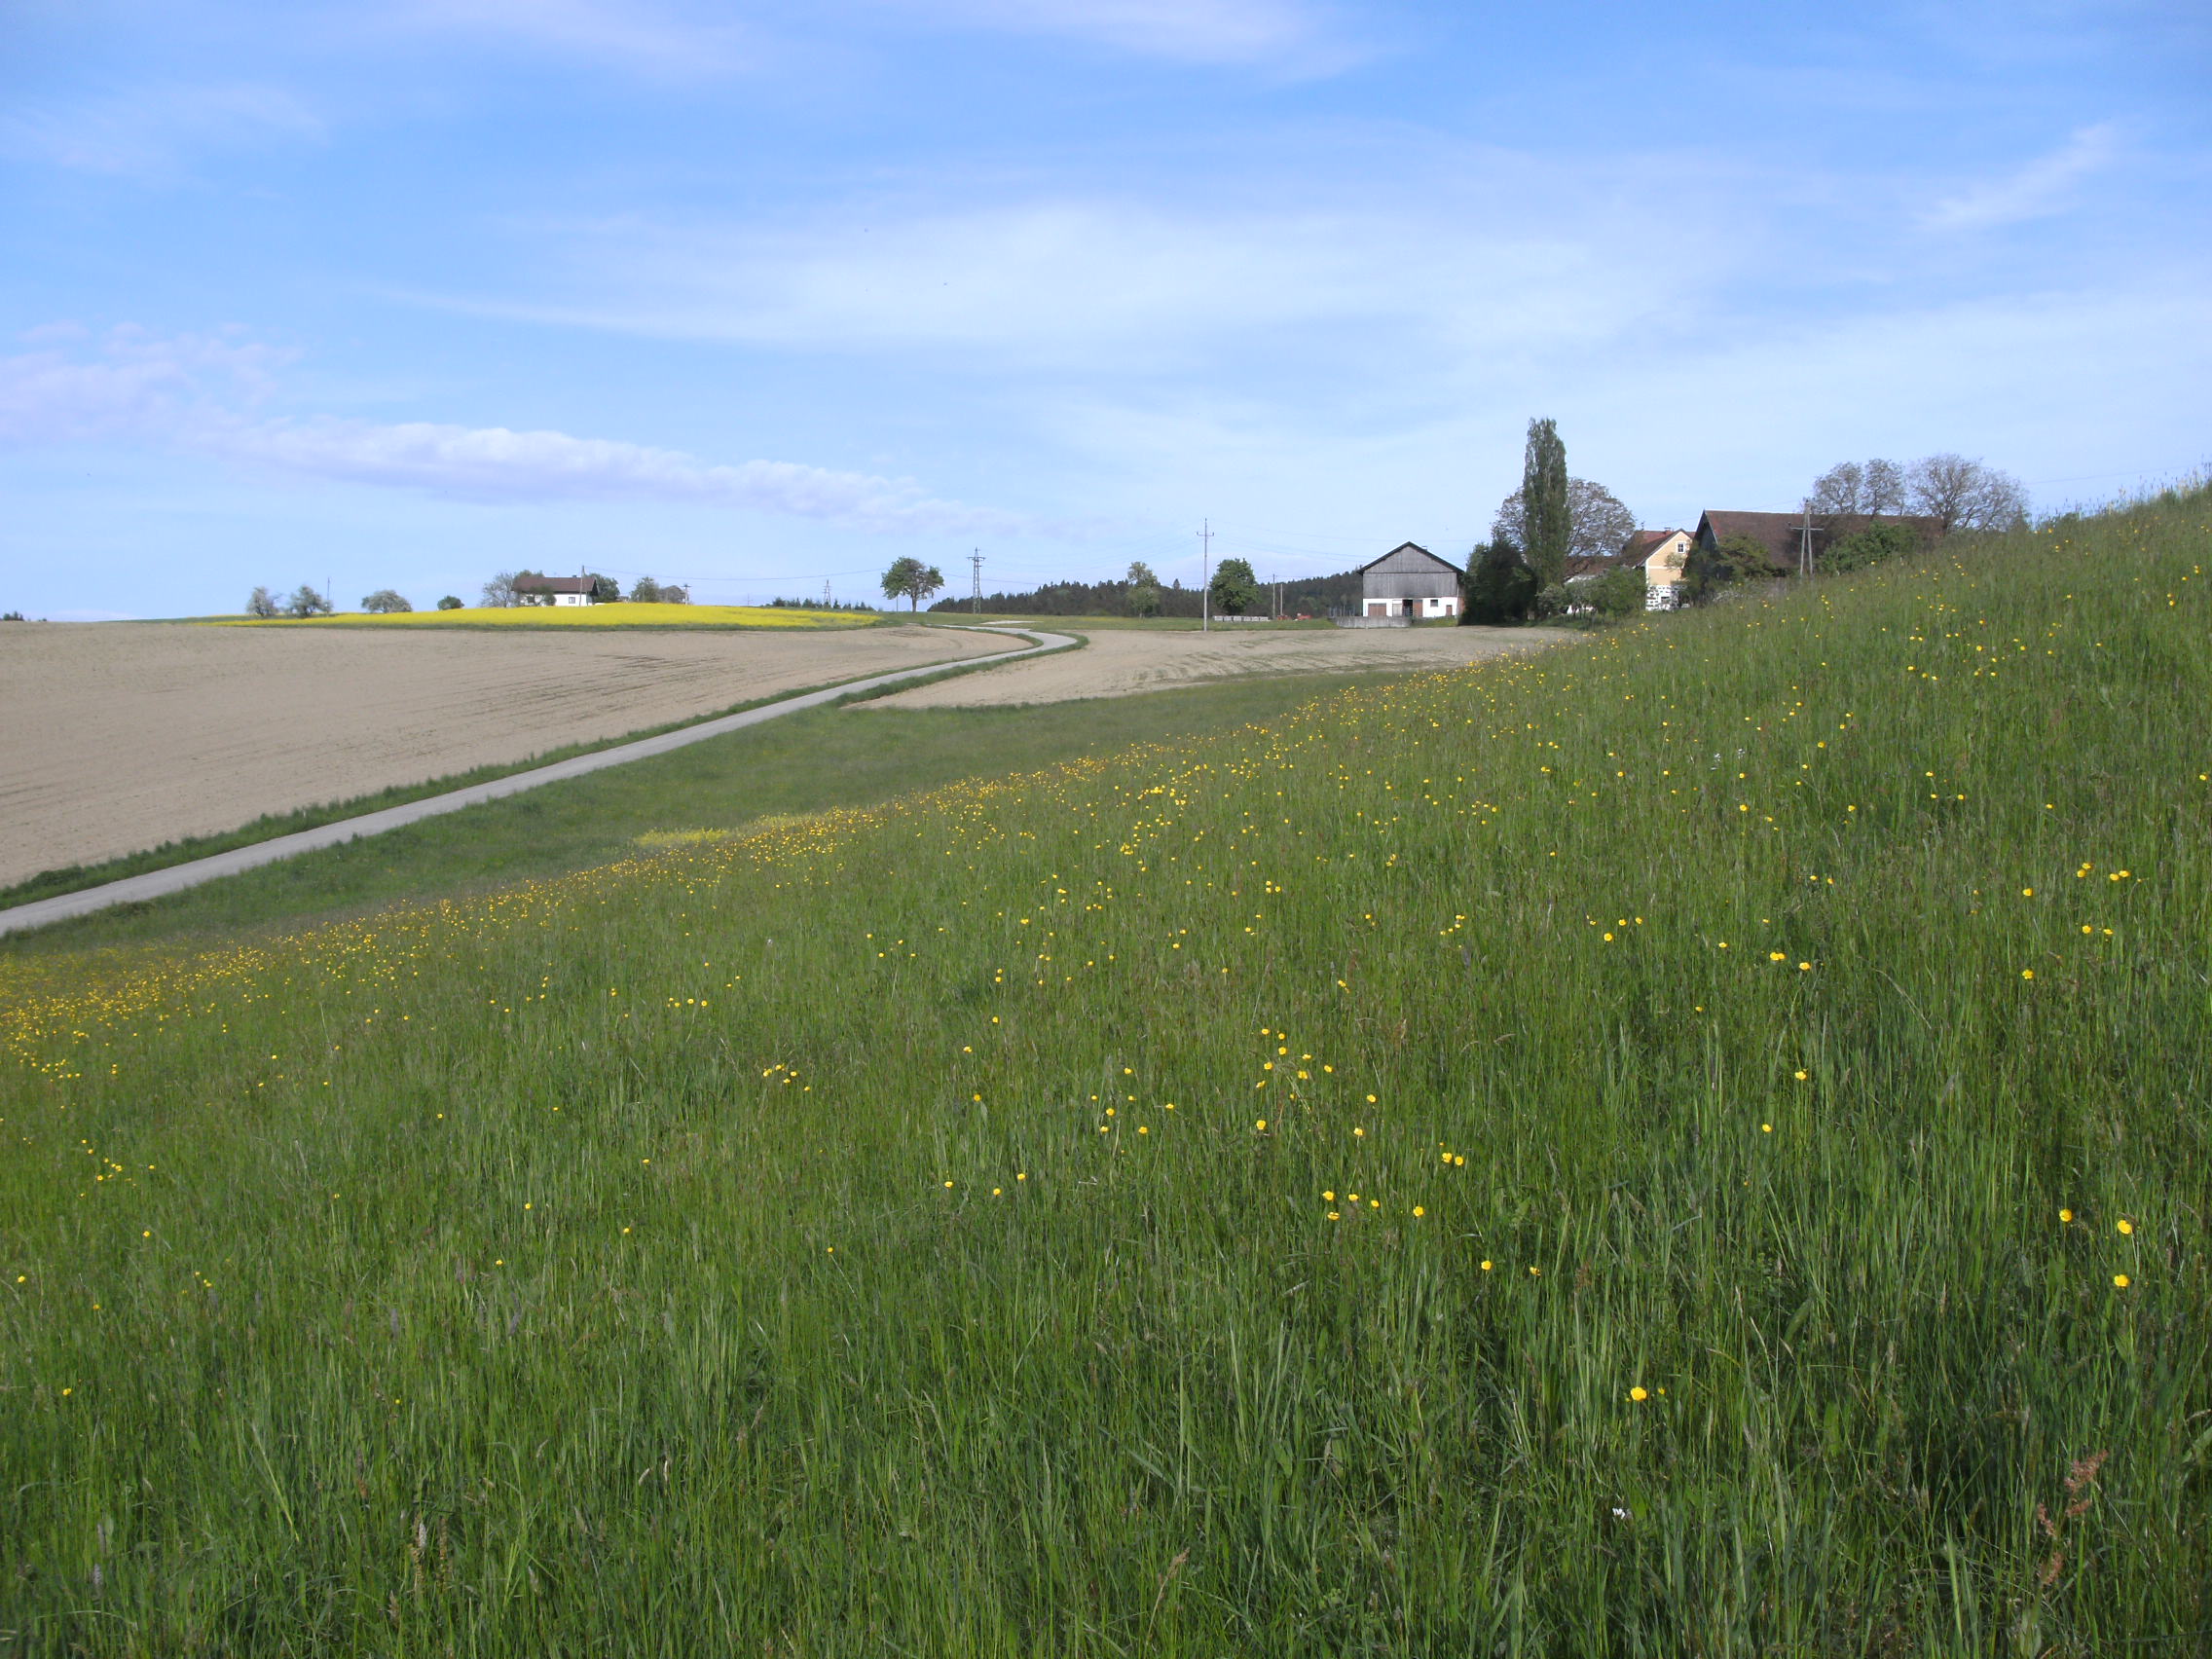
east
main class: Grassland
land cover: Grassland without tree/shrub cover
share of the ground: > 75 %
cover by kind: herbaceous plants 100 %
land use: Agriculture (excluding fallow land and kitchen gardens)
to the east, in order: Grassland without tree/shrub cover; Temporary grasslands; Rape and turnip rape; Grassland without tree/shrub cover; Maize
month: May
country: AT
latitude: 48.4921
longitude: 13.5042
